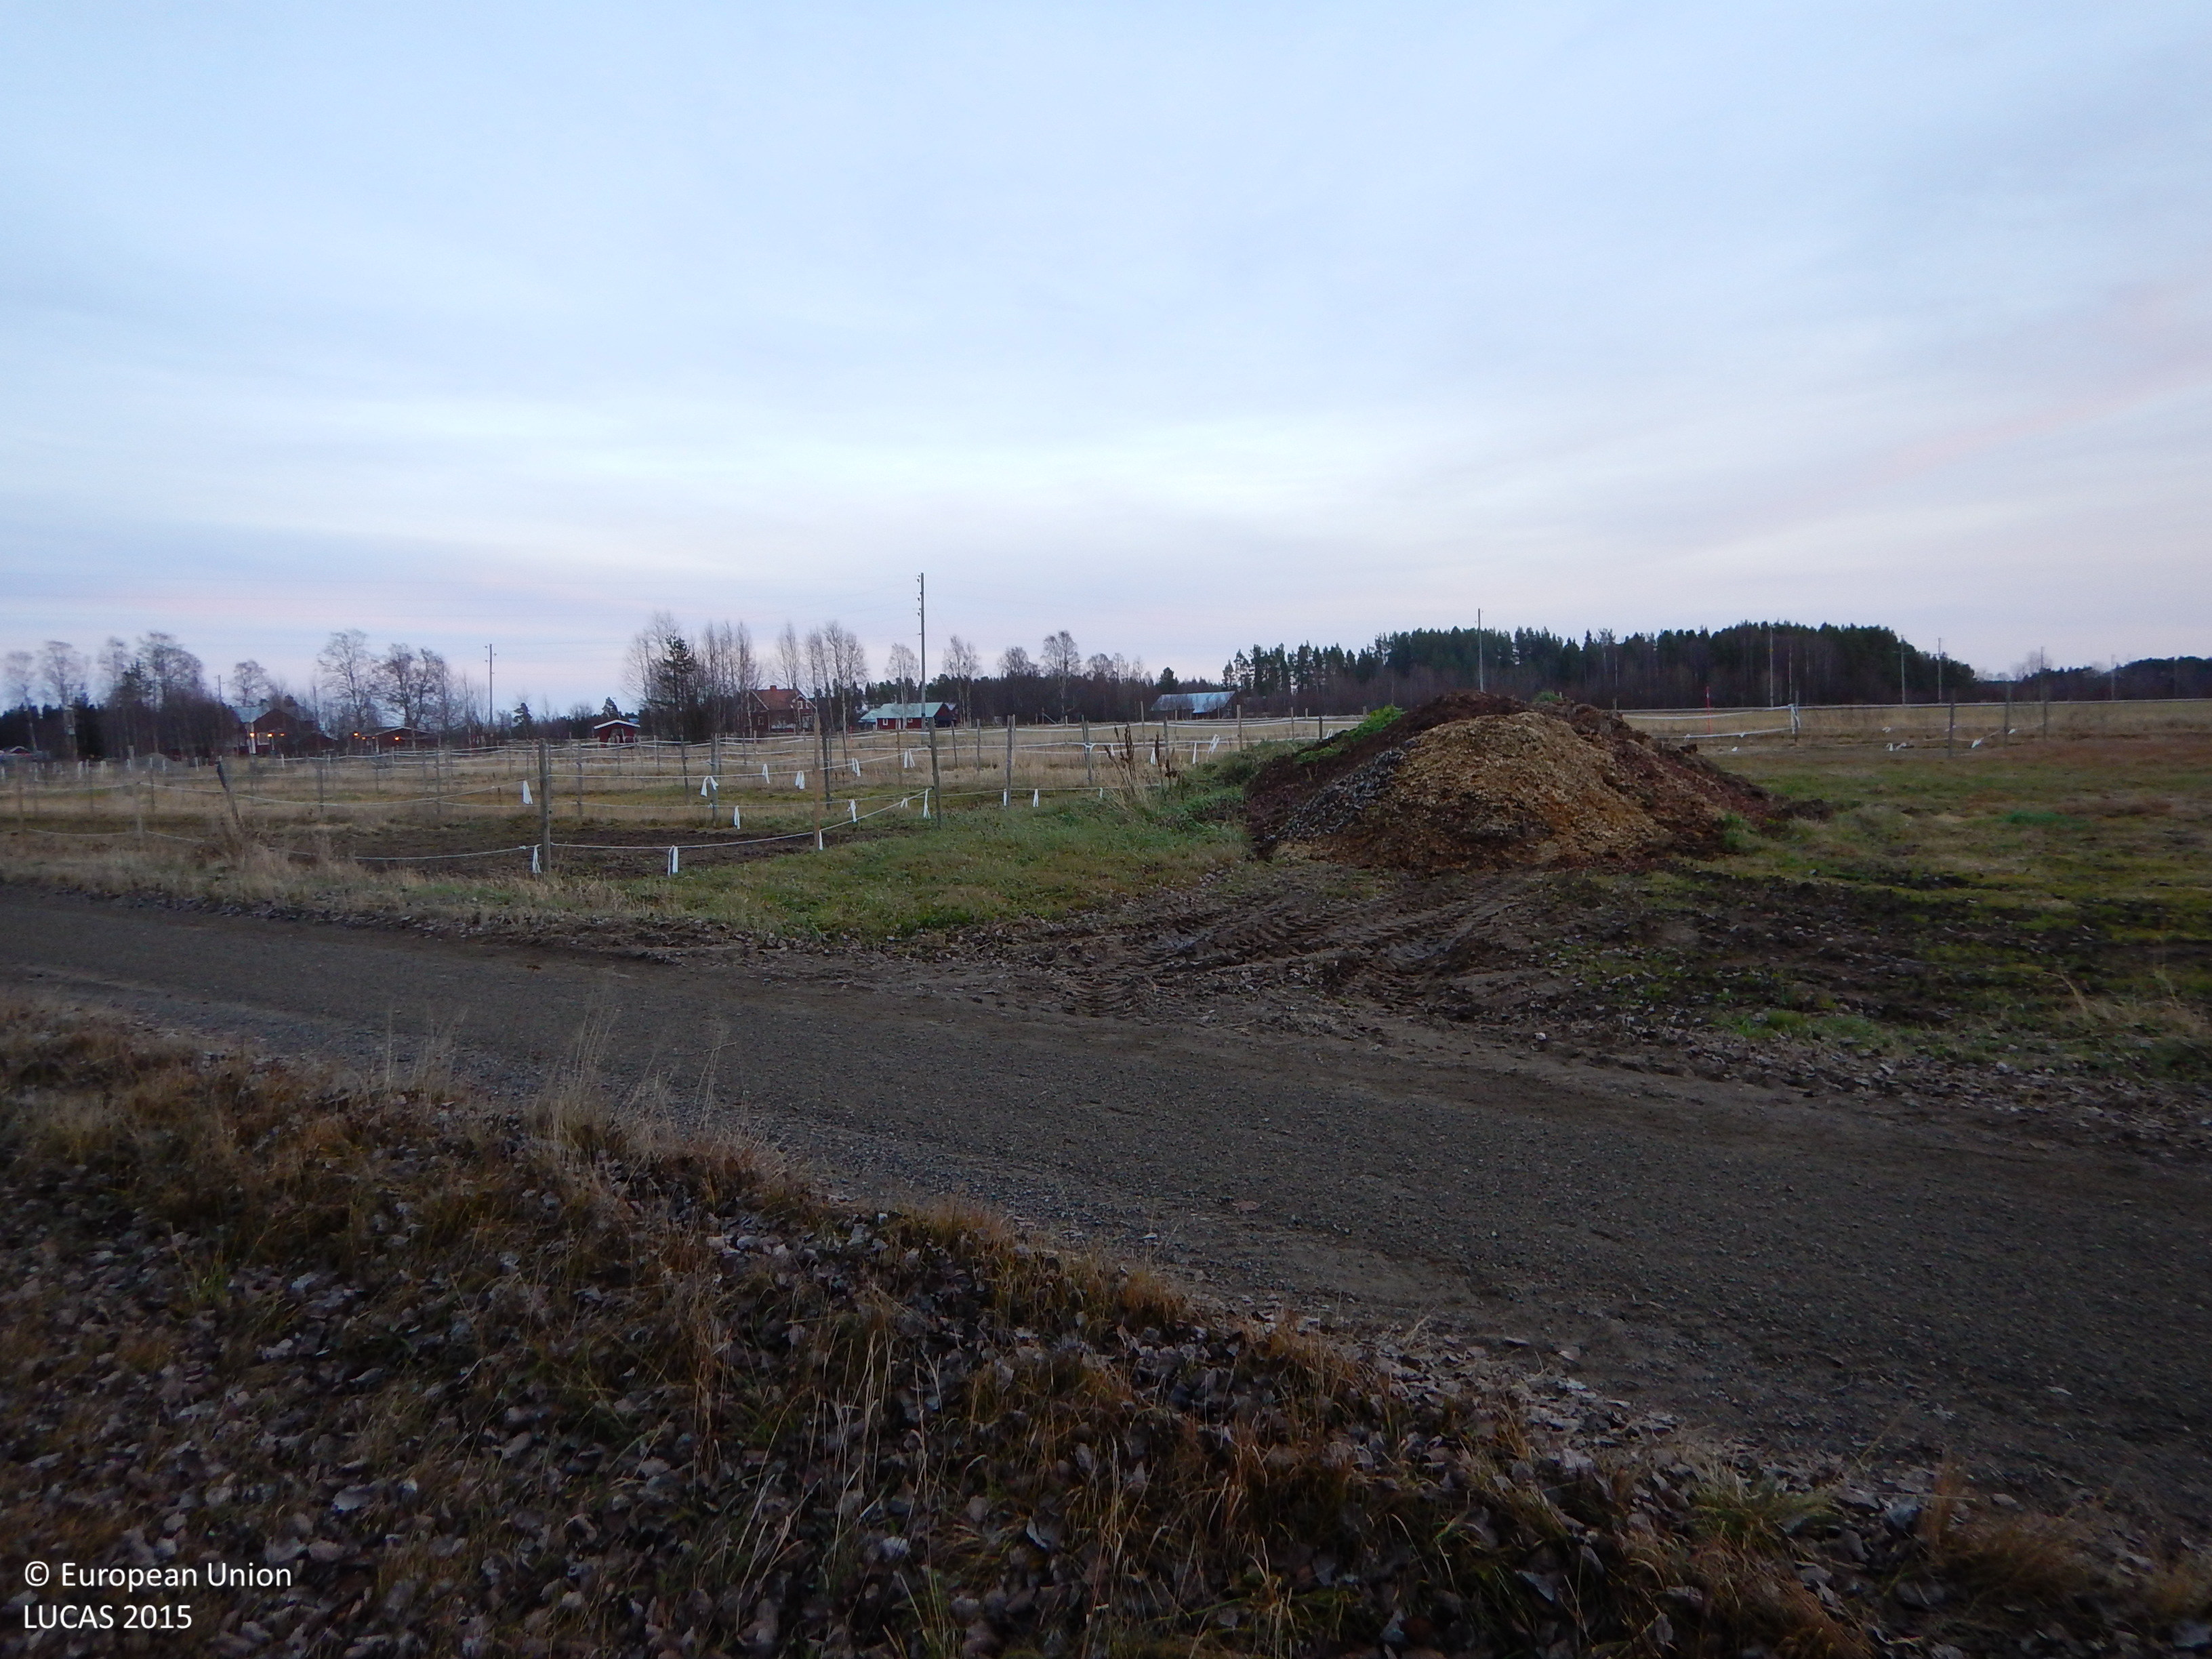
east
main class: Grassland
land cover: Grassland without tree/shrub cover
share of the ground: > 75 %
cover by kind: herbaceous plants 100 %
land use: Agriculture (excluding fallow land and kitchen gardens)
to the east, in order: Grassland without tree/shrub cover; Tracks; Grassland without tree/shrub cover; Fences; Grassland without tree/shrub cover; Fences; Tracks; Grassland without tree/shrub cover; Electric lines; Grassland without tree/shrub cover; Abandoned hedges; Grassland without tree/shrub cover
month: October
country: SE
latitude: 65.3678
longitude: 21.2627
